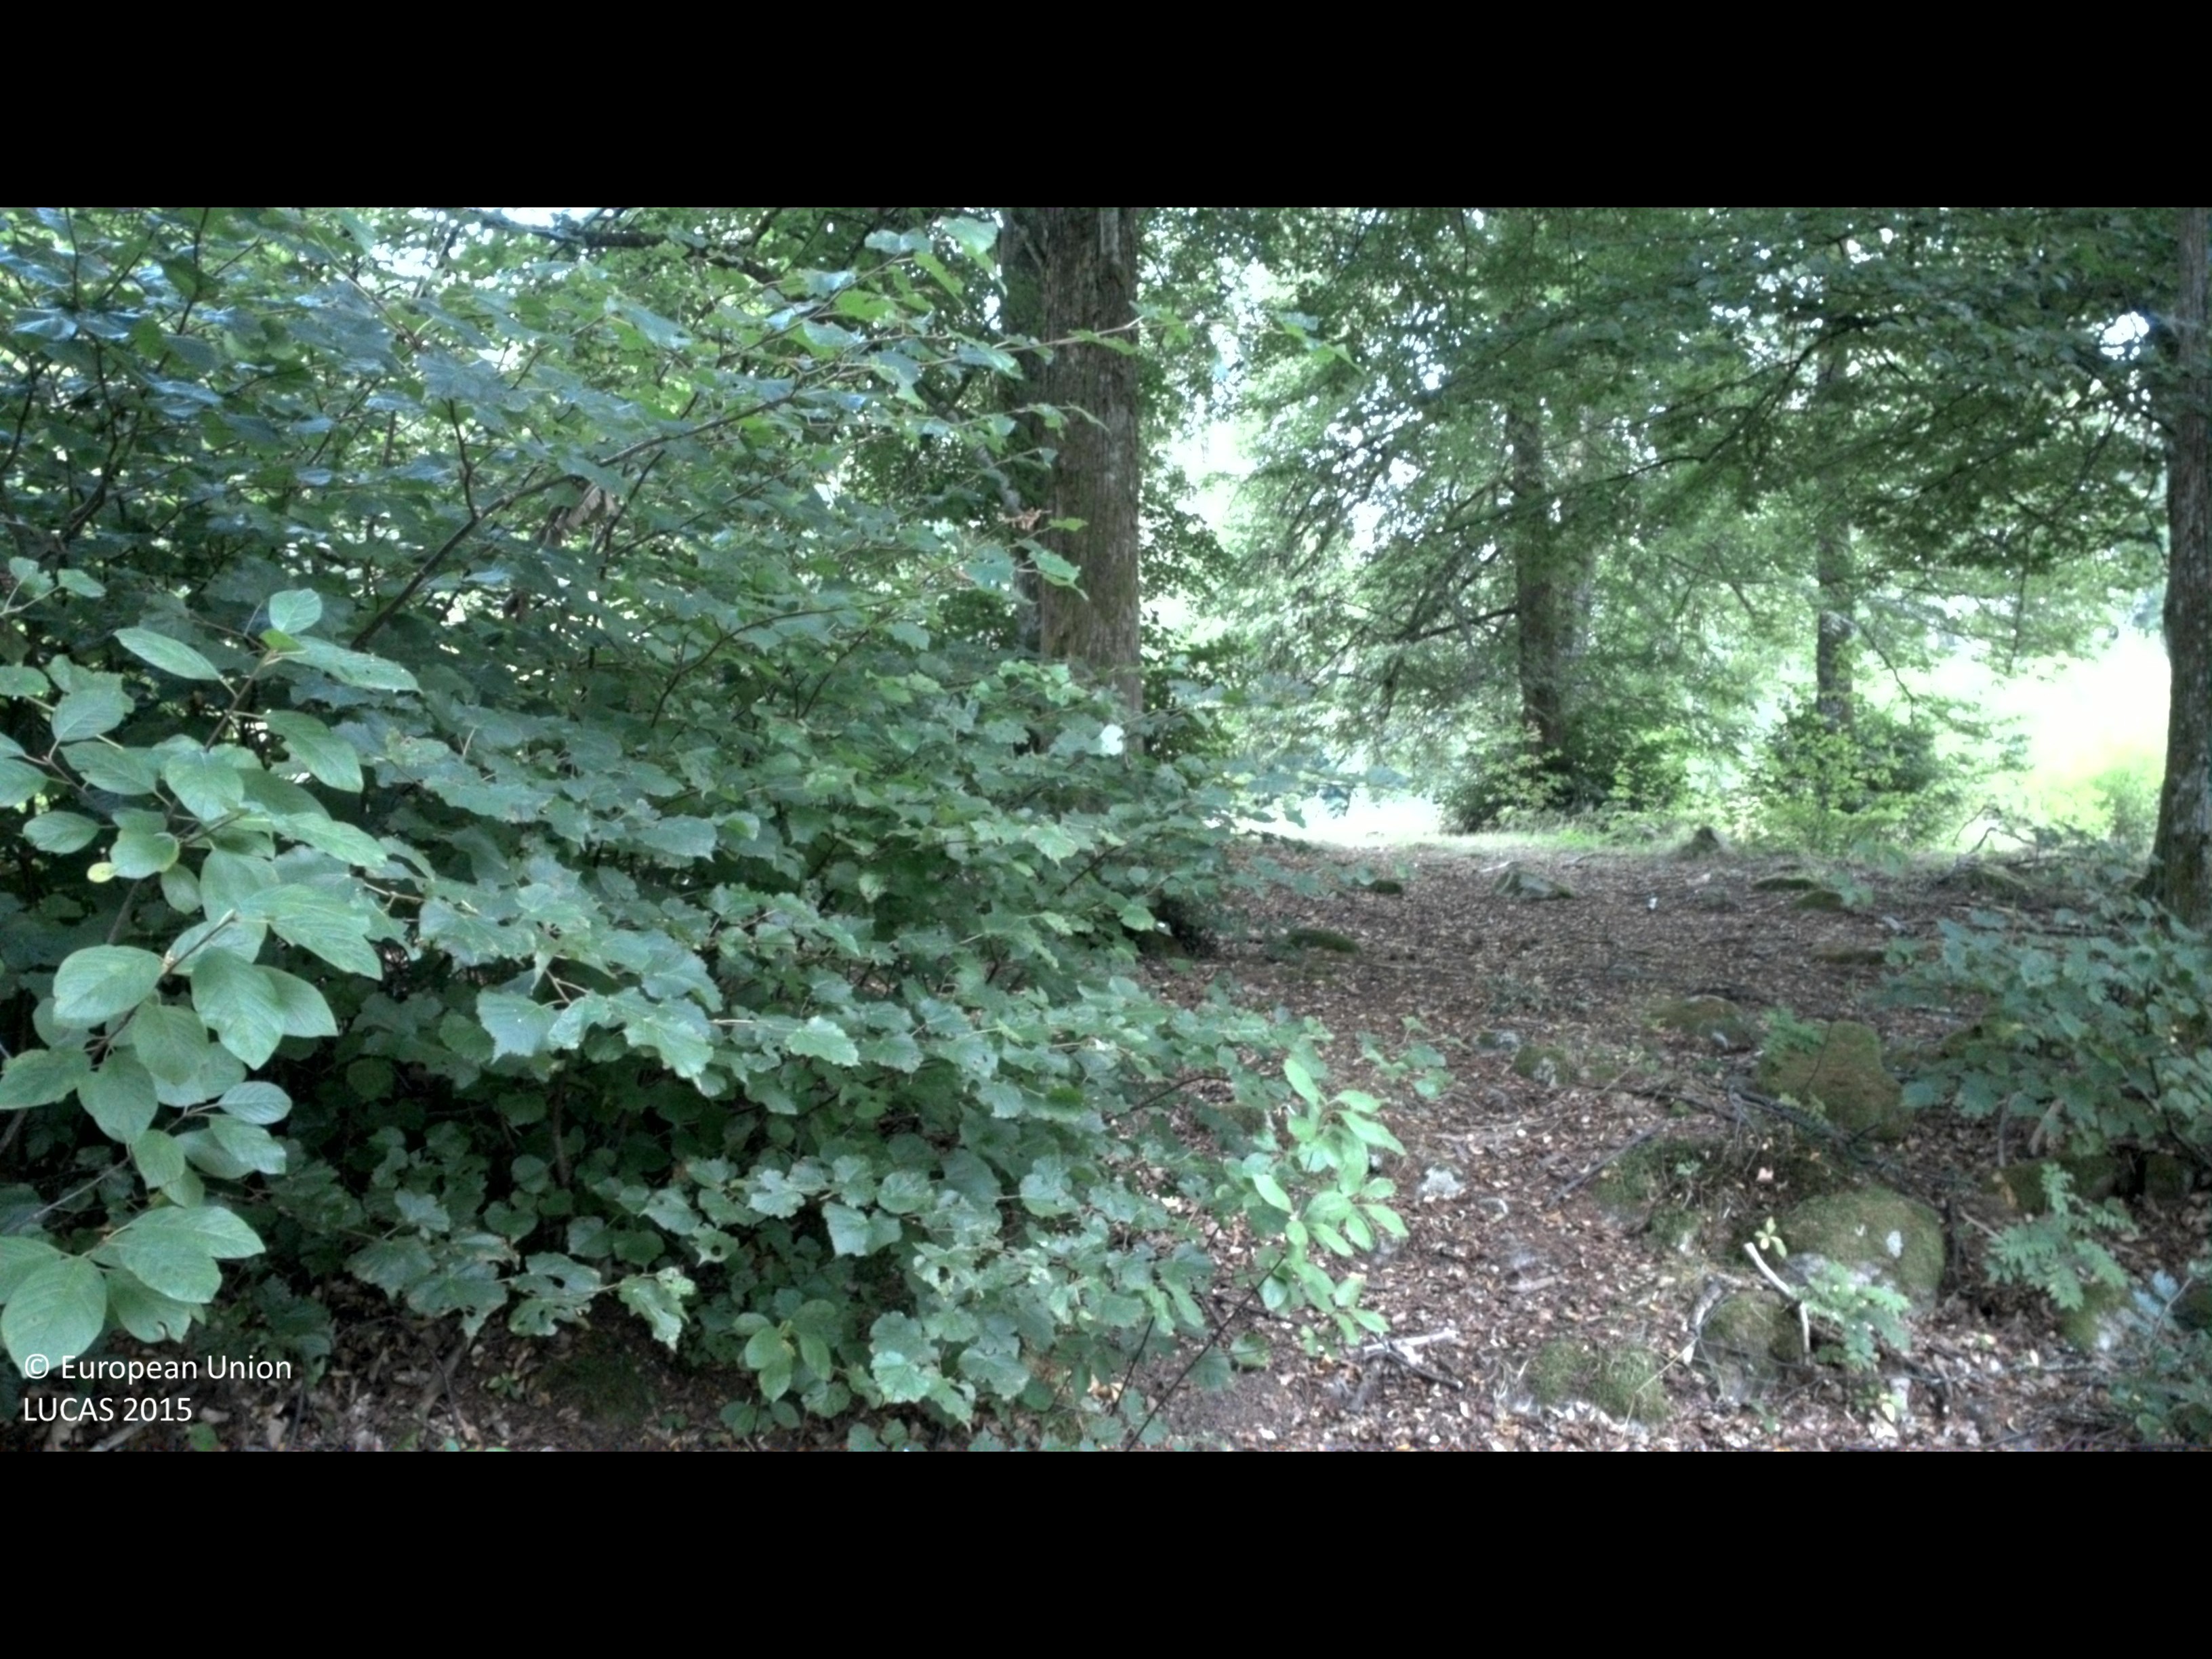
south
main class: Woodland
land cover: Broadleaved woodland
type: hemiboreal forest and nemoral coniferous forest and mixed broadleaved-coniferous forest
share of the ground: 50 - 75 %
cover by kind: broadleaved forest trees 70 %, herbaceous plants 30 %
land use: Agriculture (excluding fallow land and kitchen gardens)
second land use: Forestry
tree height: > 5 m
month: August
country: SE
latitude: 56.7600
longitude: 13.1864
